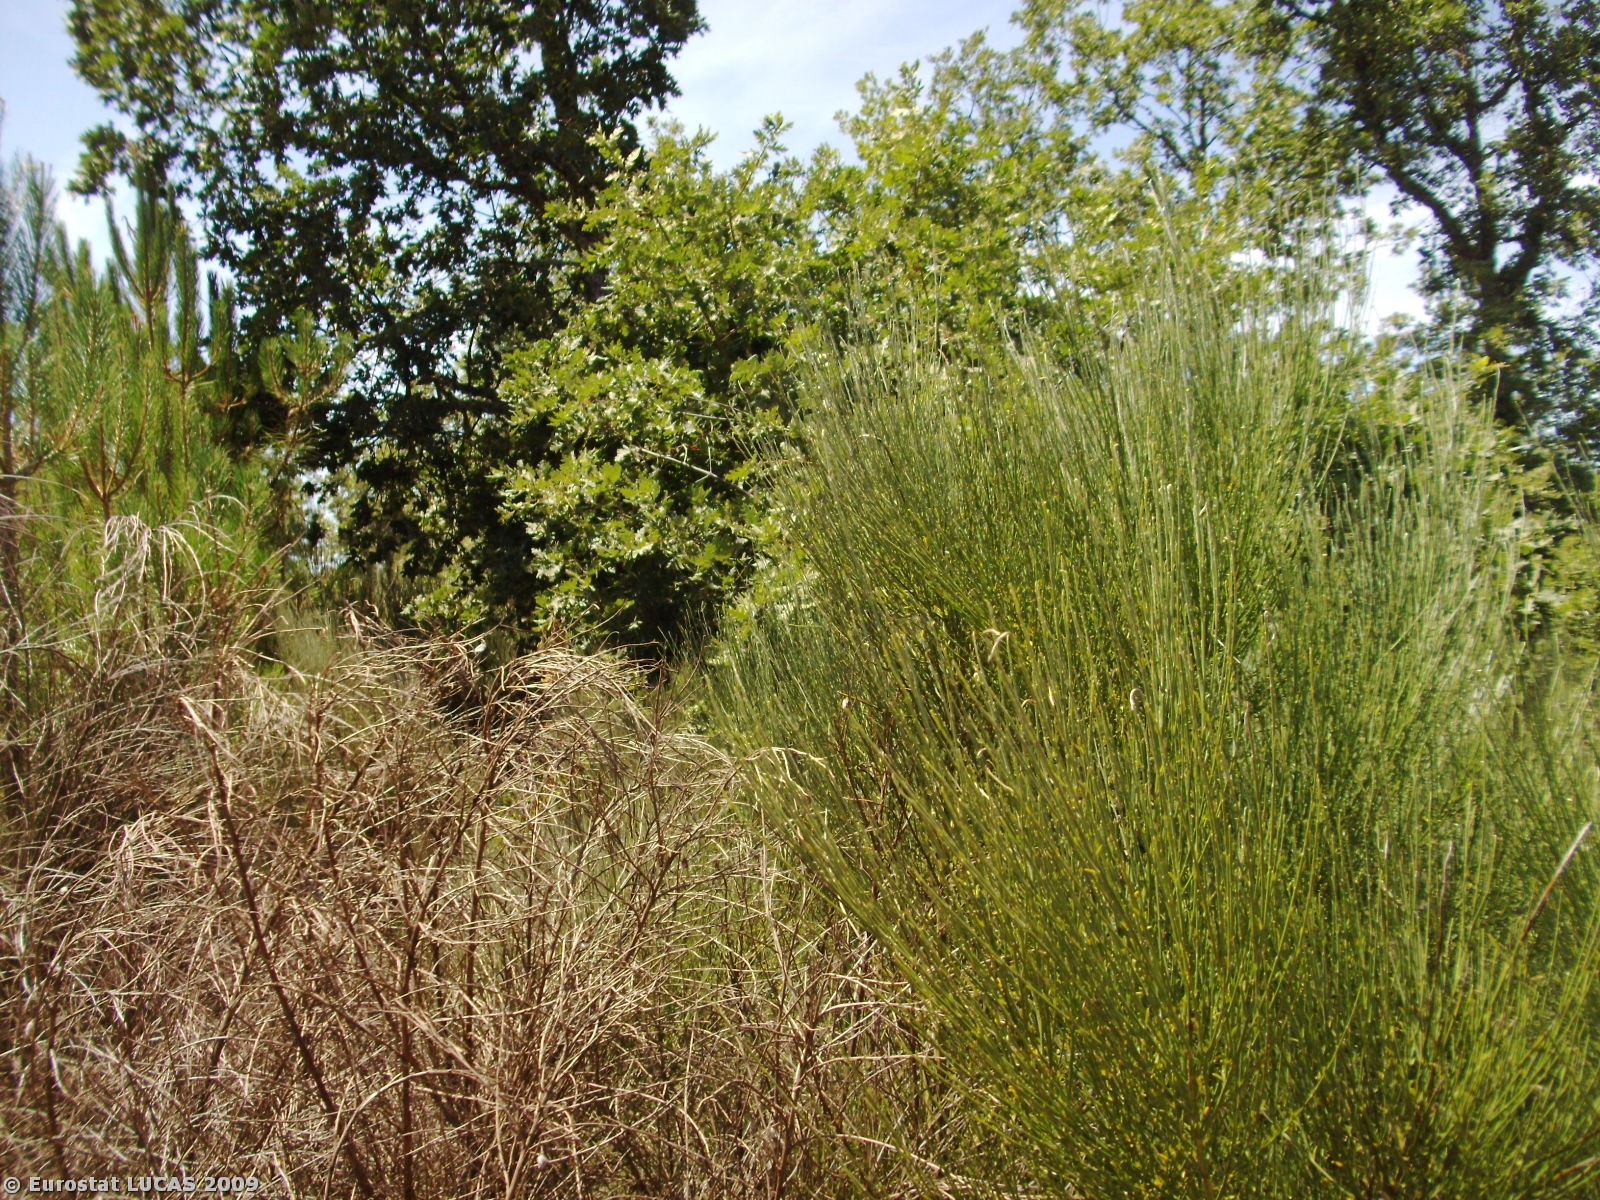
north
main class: Woodland
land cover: Mixed woodland
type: coniferous forest of the mediterranean region
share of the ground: > 75 %
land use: Forestry
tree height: > 5 m
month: July
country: PT
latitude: 40.3798
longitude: -6.9752
